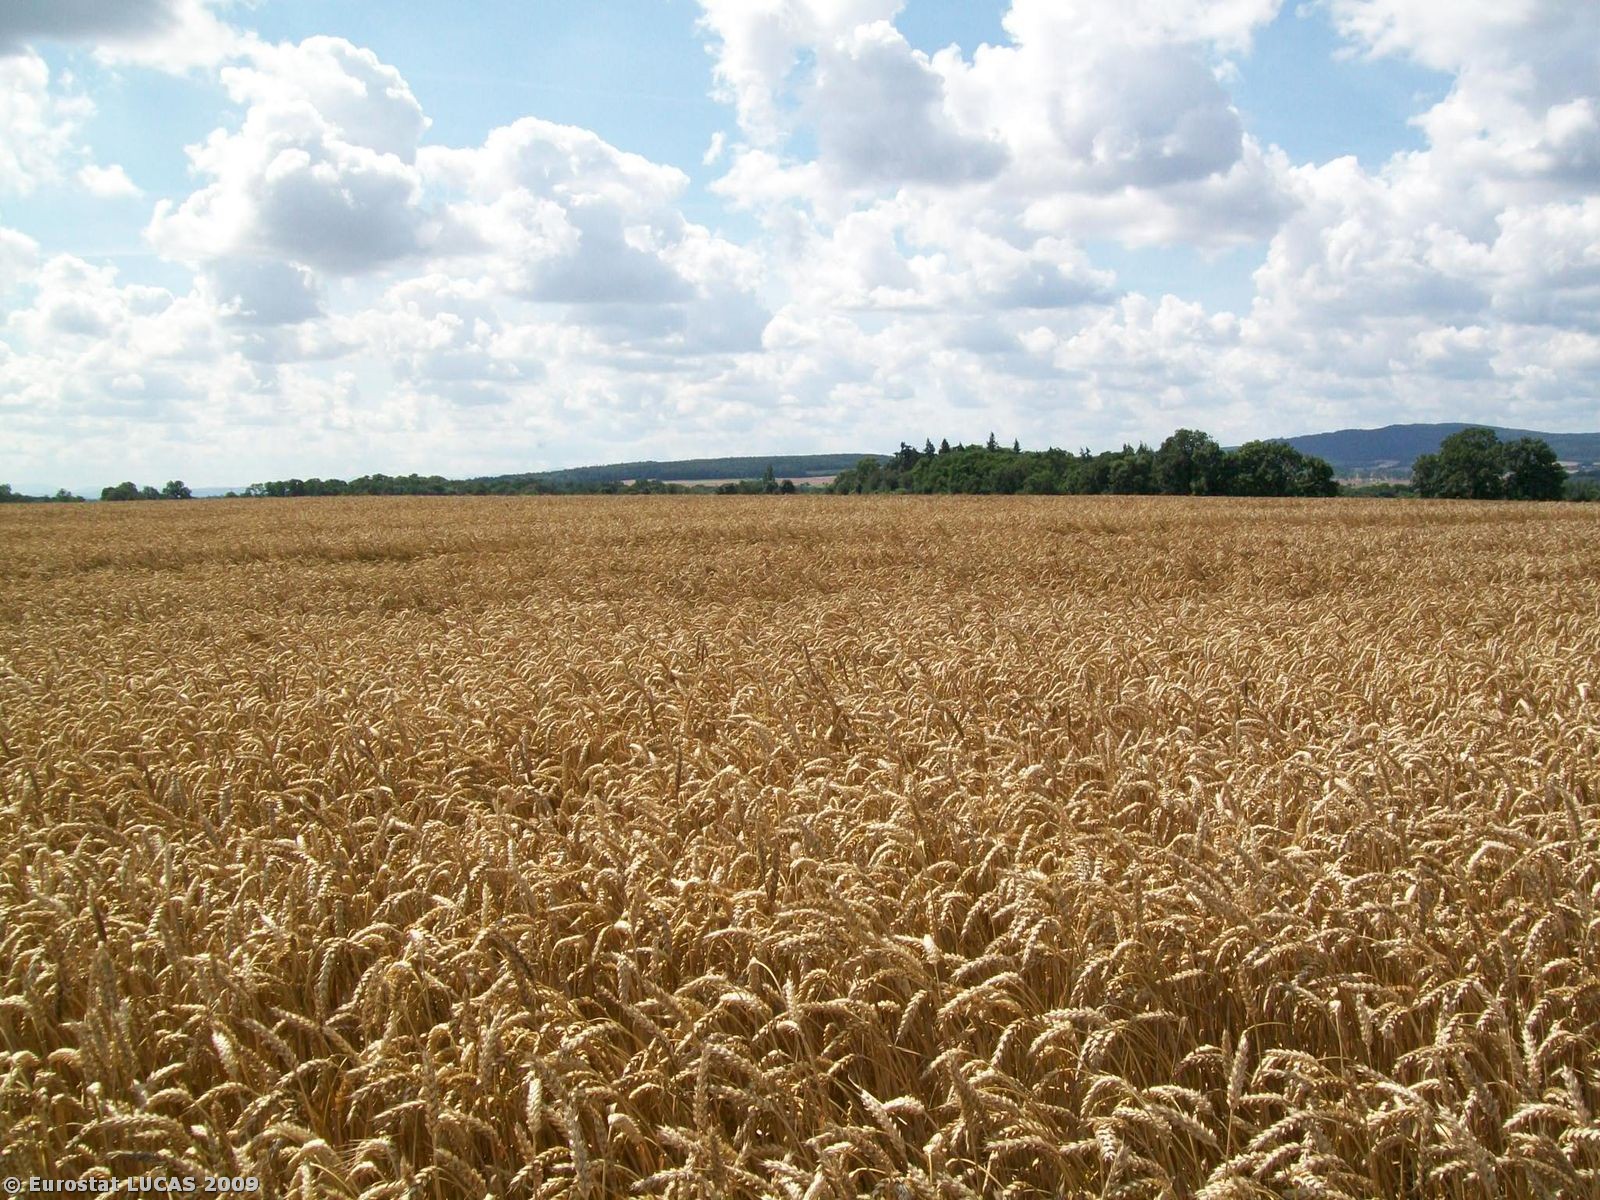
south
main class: Cropland
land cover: Common wheat
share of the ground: > 75 %
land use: Agriculture (excluding fallow land and kitchen gardens)
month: July
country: PL
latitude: 51.1205
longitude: 16.1068
